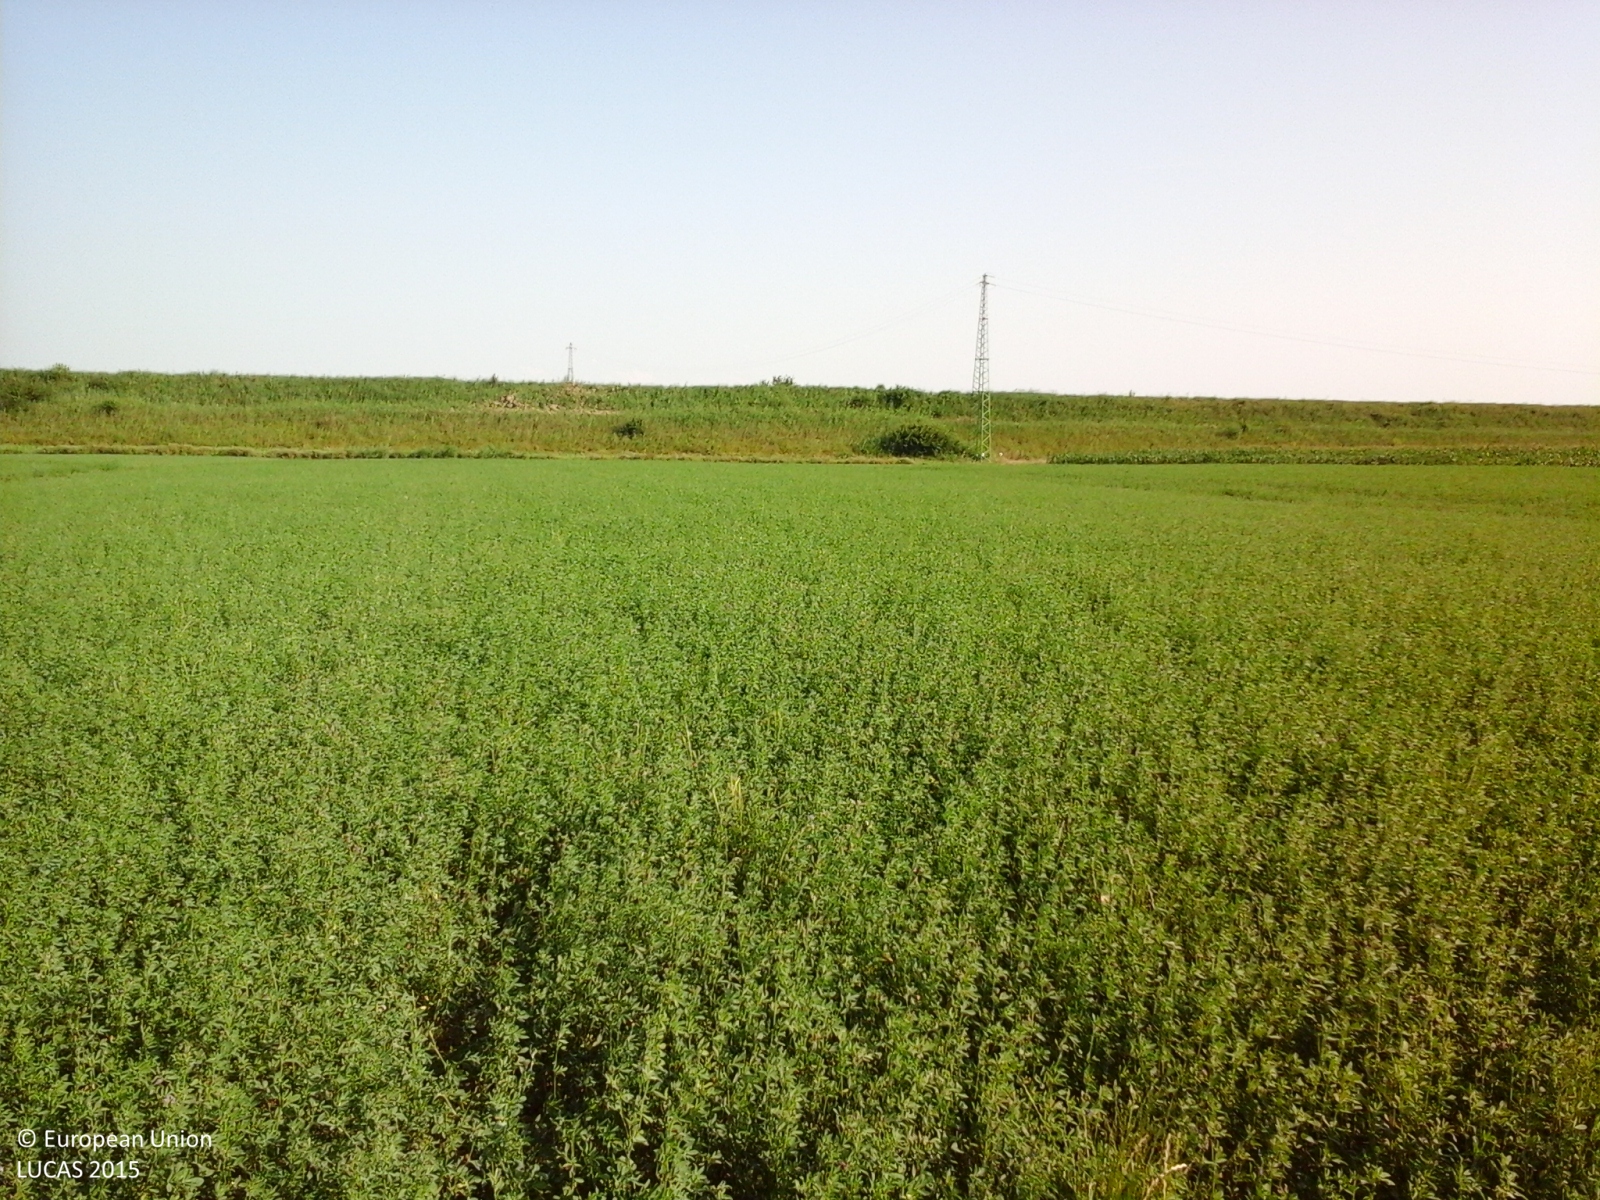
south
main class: Cropland
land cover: Lucerne
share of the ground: > 75 %
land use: Agriculture (excluding fallow land and kitchen gardens)
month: July
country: IT
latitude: 44.5540
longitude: 11.6456
